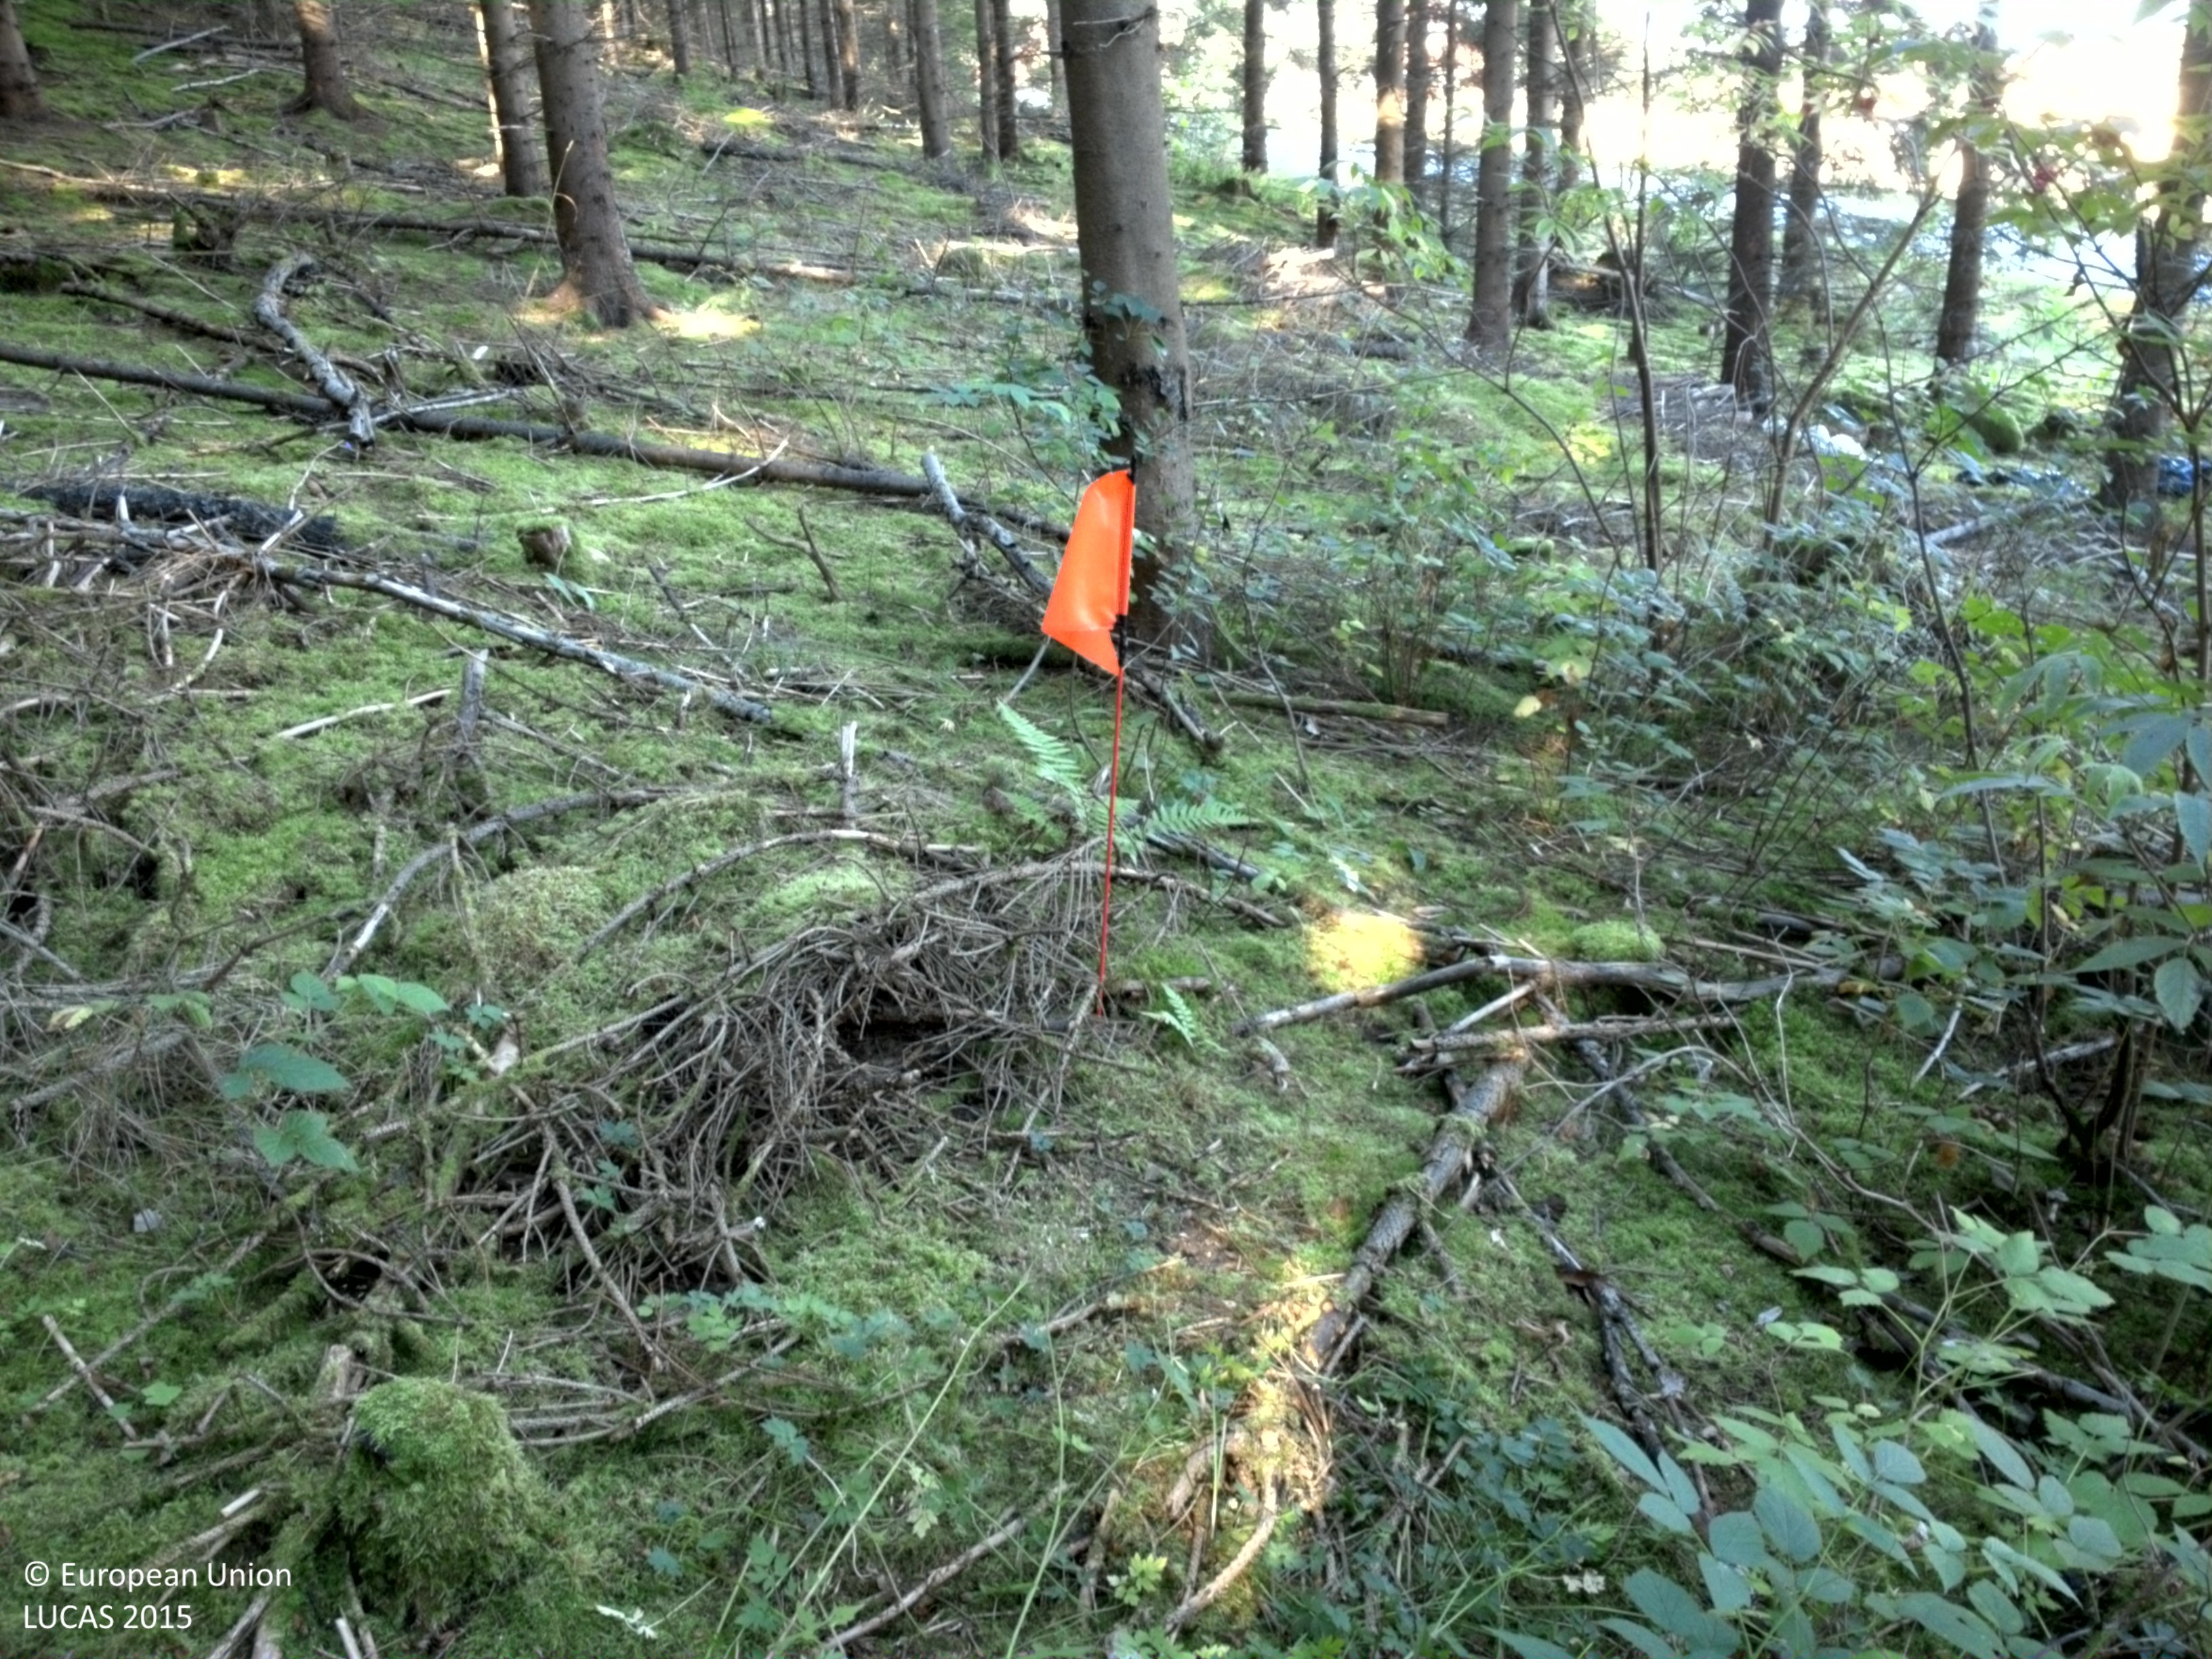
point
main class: Woodland
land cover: Spruce dominated coniferous woodland
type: boreal forest
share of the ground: > 75 %
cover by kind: coniferous forest trees 90 %, herbaceous plants 5 %, lichens and mosses 5 %
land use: Forestry
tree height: > 5 m
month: August
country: SE
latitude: 59.6036
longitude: 17.4544
